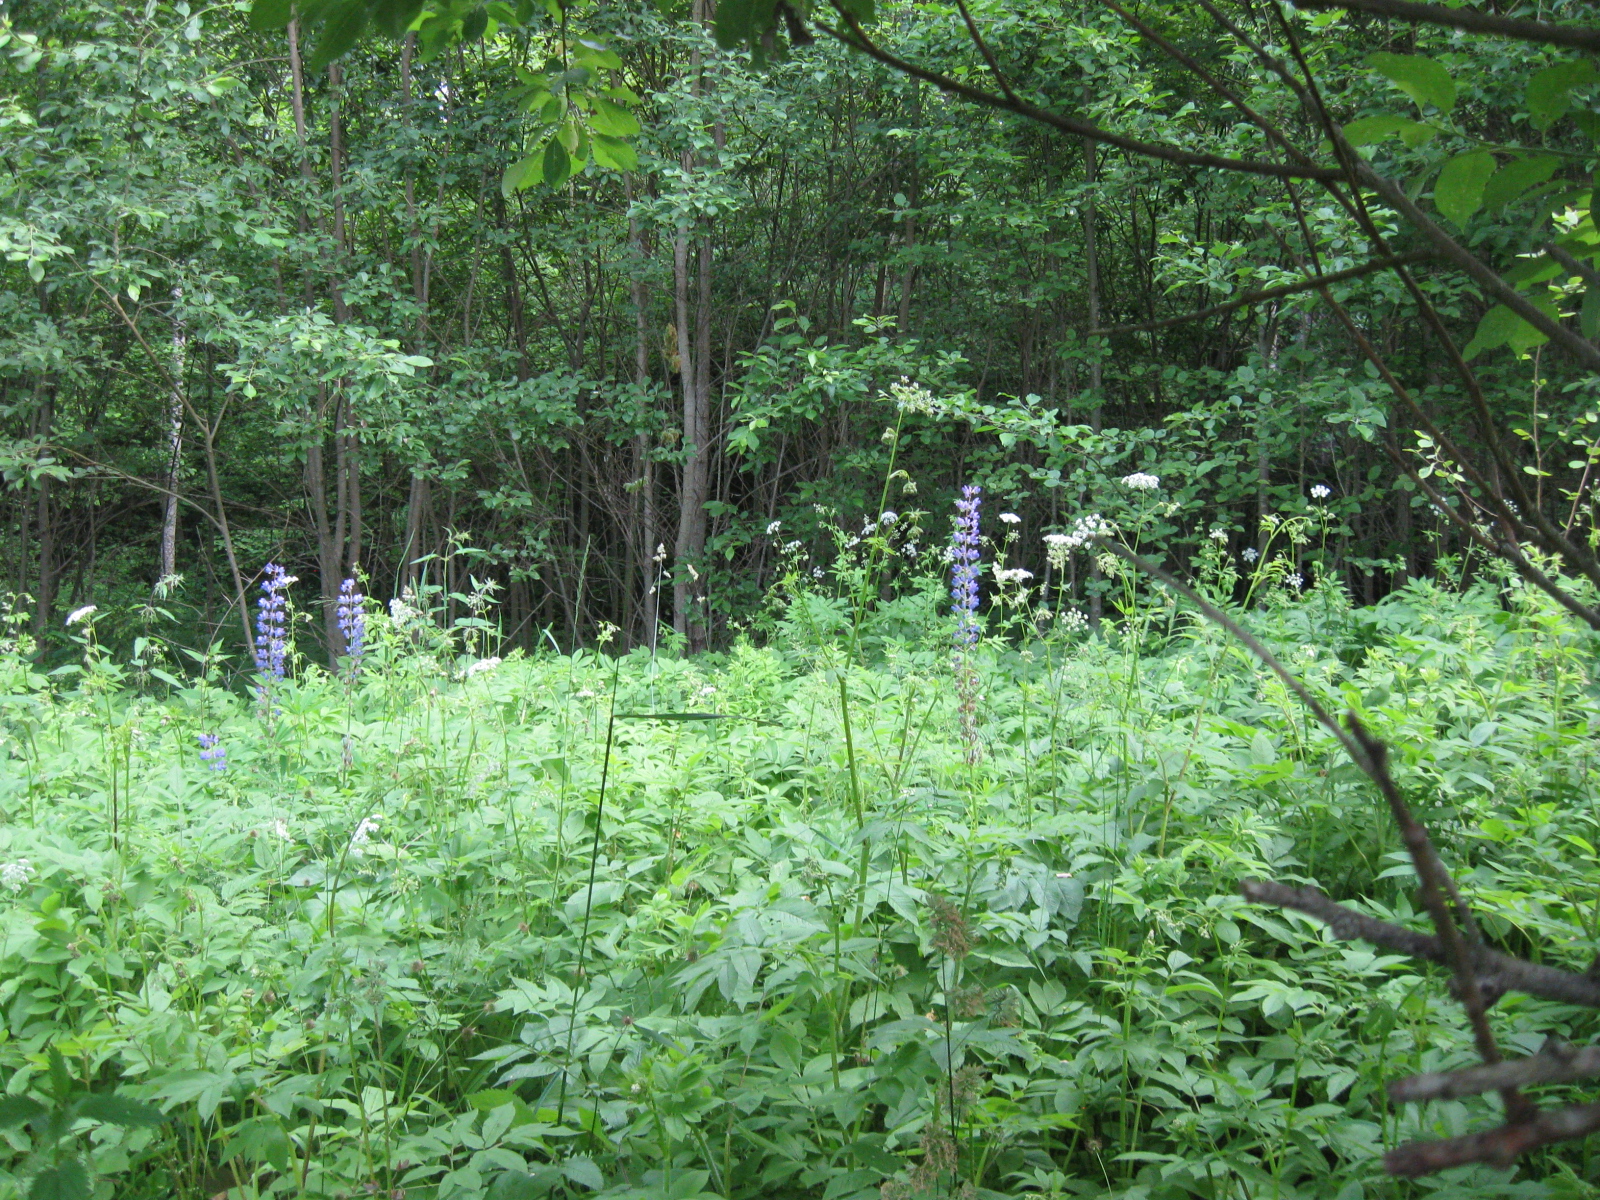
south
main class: Woodland
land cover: Broadleaved woodland
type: floodplain forest
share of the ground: 50 - 75 %
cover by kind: broadleaved forest trees 70 %, herbaceous plants 30 %
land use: Forestry
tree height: > 5 m
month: June
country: LT
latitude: 54.4334
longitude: 24.5810
